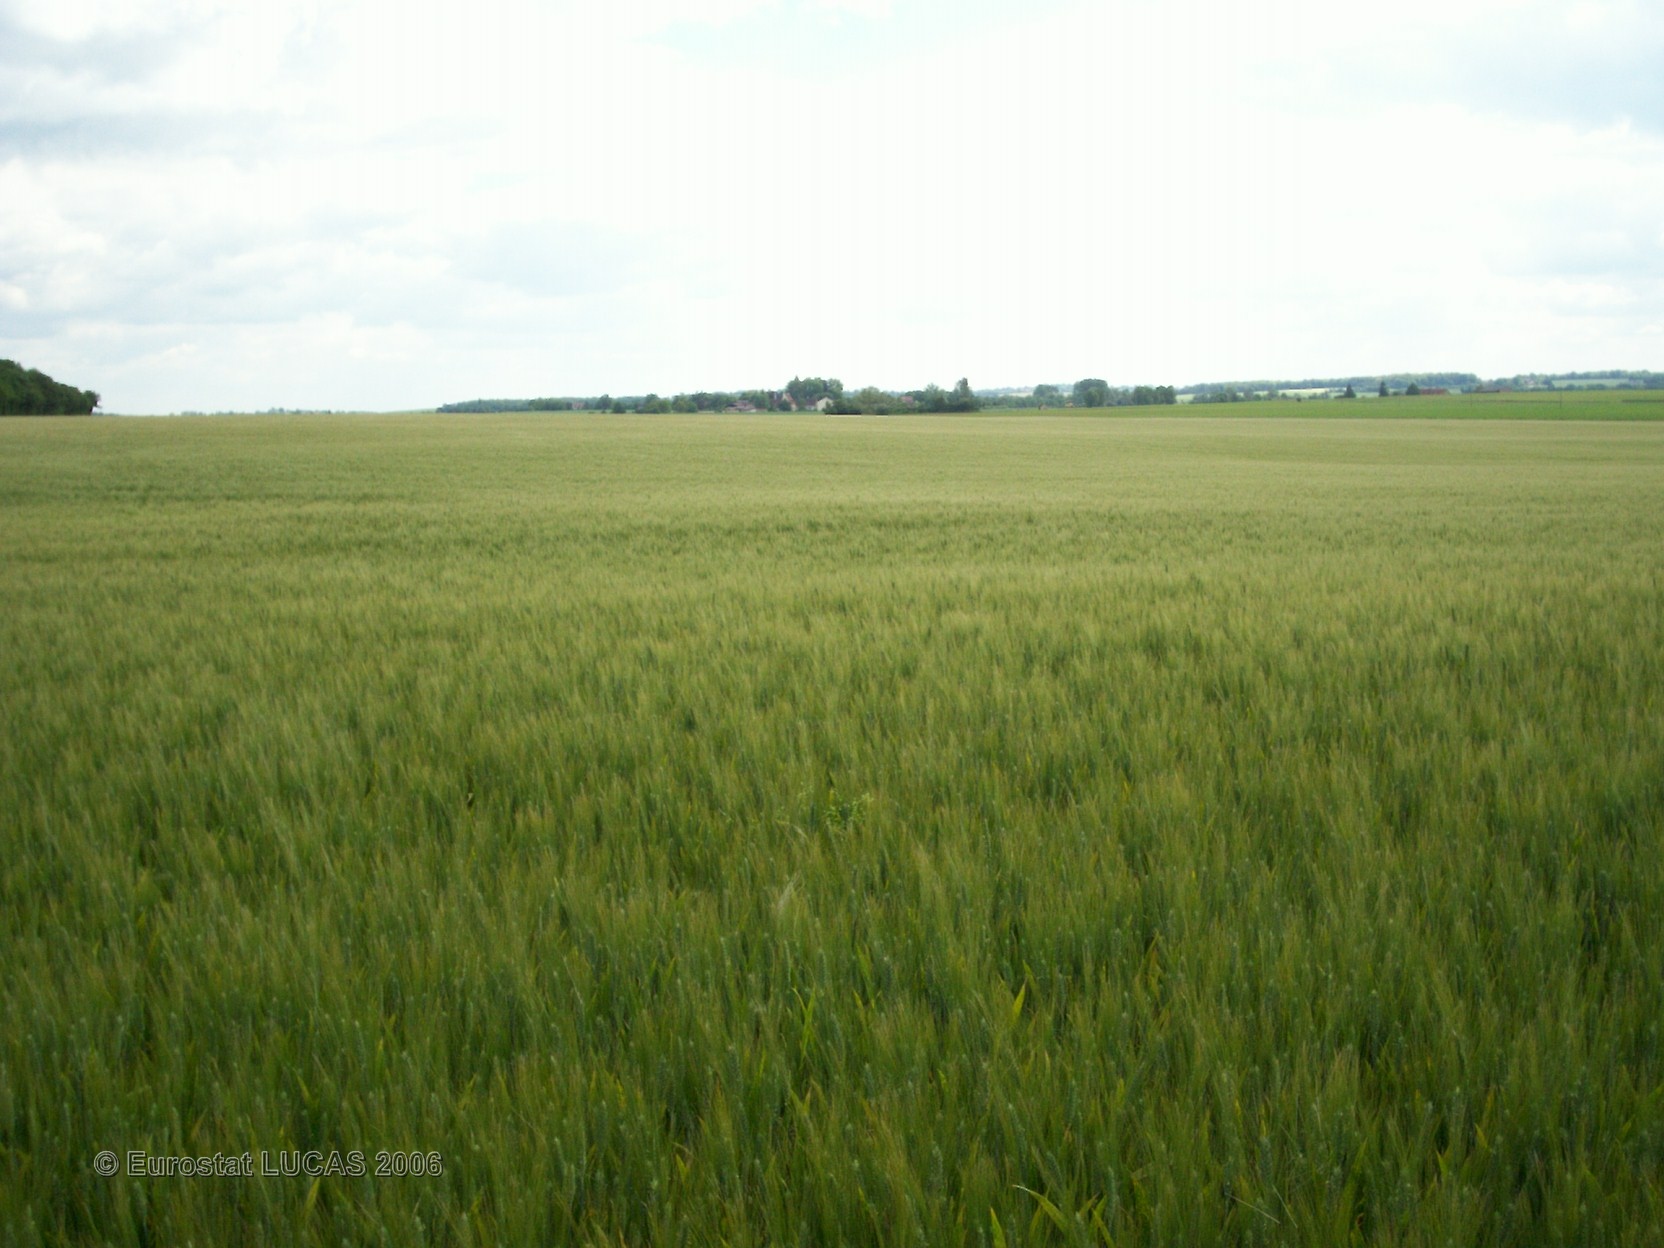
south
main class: Cropland
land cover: Durum wheat
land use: Agriculture (excluding fallow land and kitchen gardens)
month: June
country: FR
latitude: 47.0567
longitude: 2.9256
